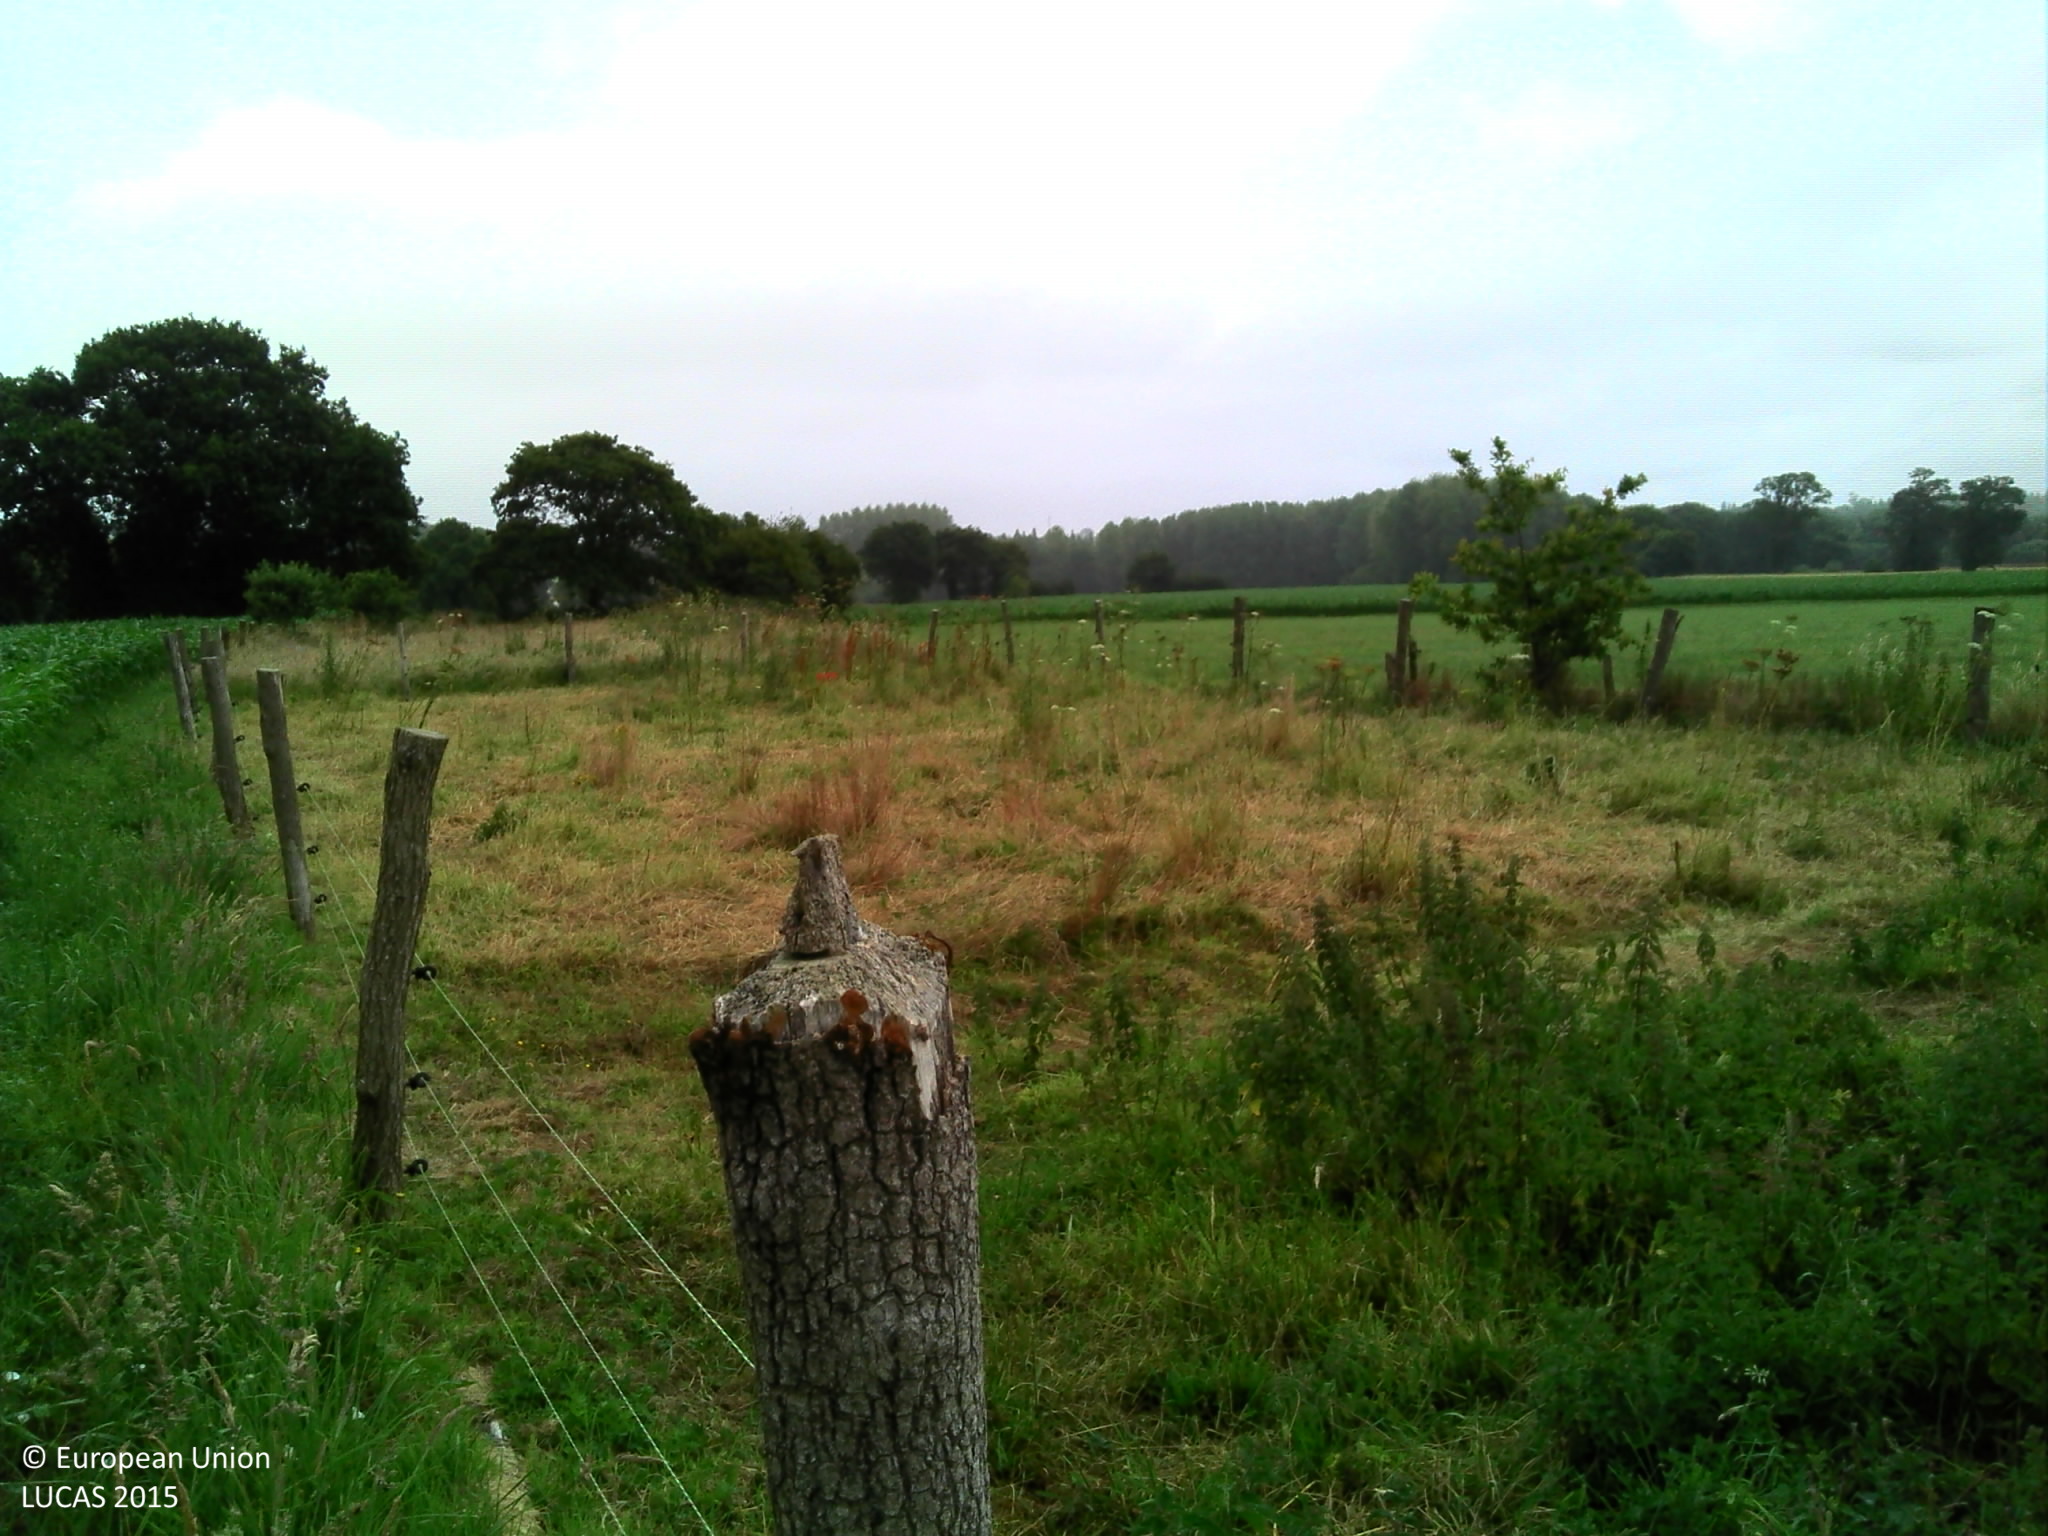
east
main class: Grassland
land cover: Grassland without tree/shrub cover
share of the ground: > 75 %
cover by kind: herbaceous plants 80 %, lichens and mosses 10 %, unconsolidated bare surface 10 %
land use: Agriculture (excluding fallow land and kitchen gardens)
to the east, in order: Grassland without tree/shrub cover; Fences; Maize; Common wheat
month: July
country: FR
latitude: 48.5871
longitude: -2.3008
